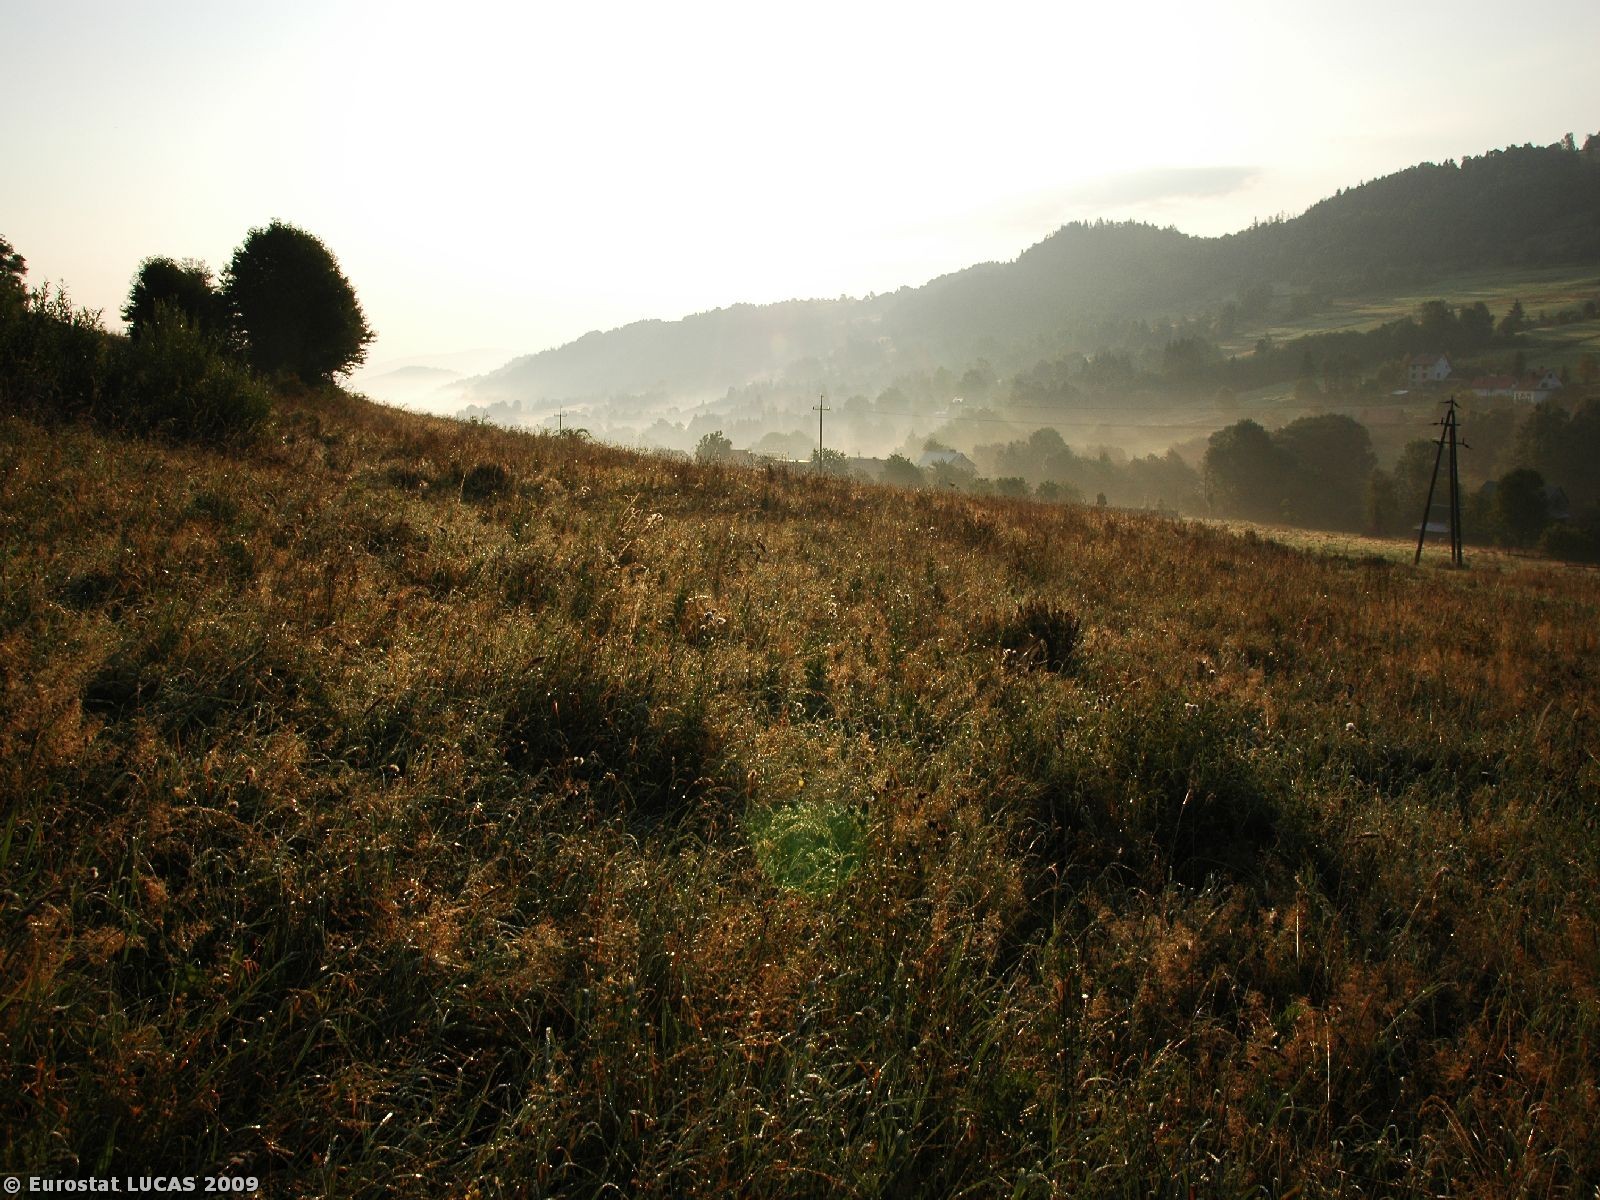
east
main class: Grassland
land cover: Grassland without tree/shrub cover
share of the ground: > 75 %
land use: Unused
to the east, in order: Grassland without tree/shrub cover; Tracks; Grassland without tree/shrub cover; Other fresh vegetables; Grassland without tree/shrub cover; Electric lines; Grassland without tree/shrub cover; Artificial constructions in urban areas
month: August
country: PL
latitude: 49.5567
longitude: 18.9941
